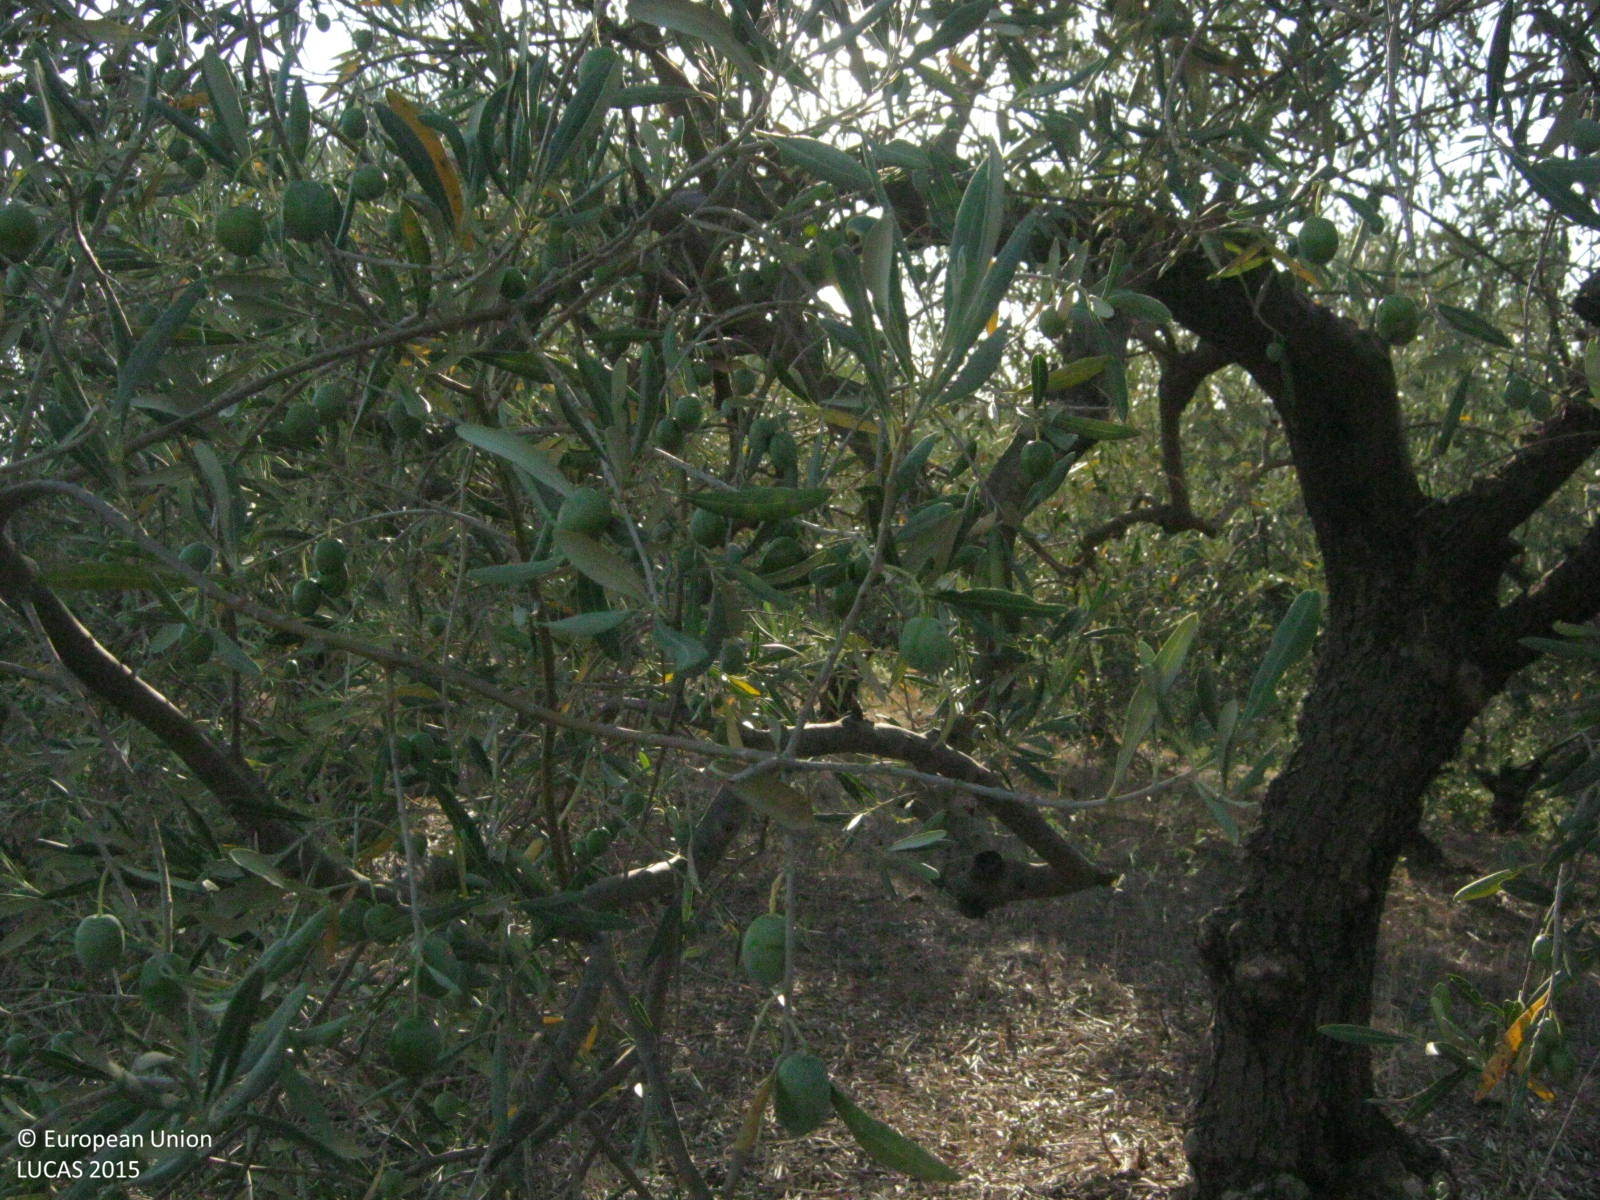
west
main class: Shrubland
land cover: Shrubland with sparse tree cover
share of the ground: > 75 %
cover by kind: shrubs 85 %, broadleaved forest trees 5 %, herbaceous plants 5 %, unconsolidated bare surface 5 %
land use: Semi-natural and natural areas not in use
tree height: < 5 m
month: August
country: GR
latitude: 39.1049
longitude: 21.1098
